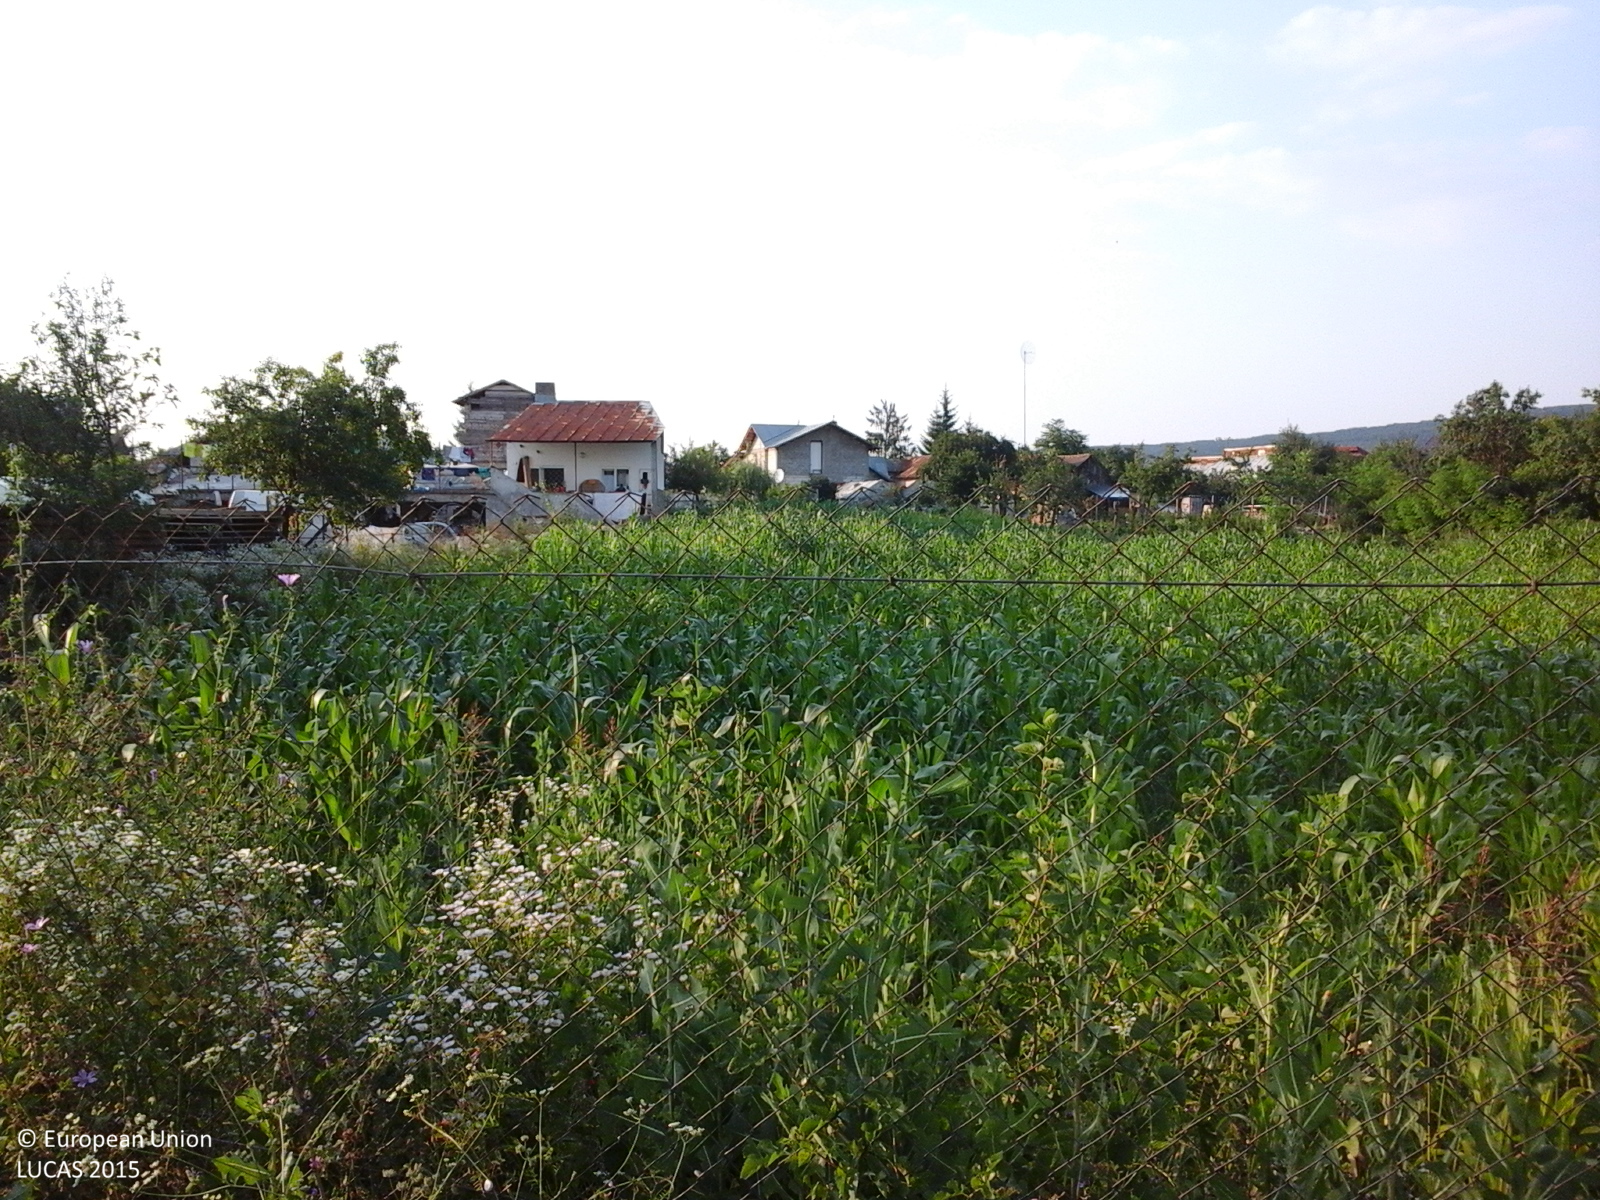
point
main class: Cropland
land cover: Maize
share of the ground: > 75 %
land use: Agriculture (excluding fallow land and kitchen gardens)
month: July
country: RO
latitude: 44.8599
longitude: 25.6517
